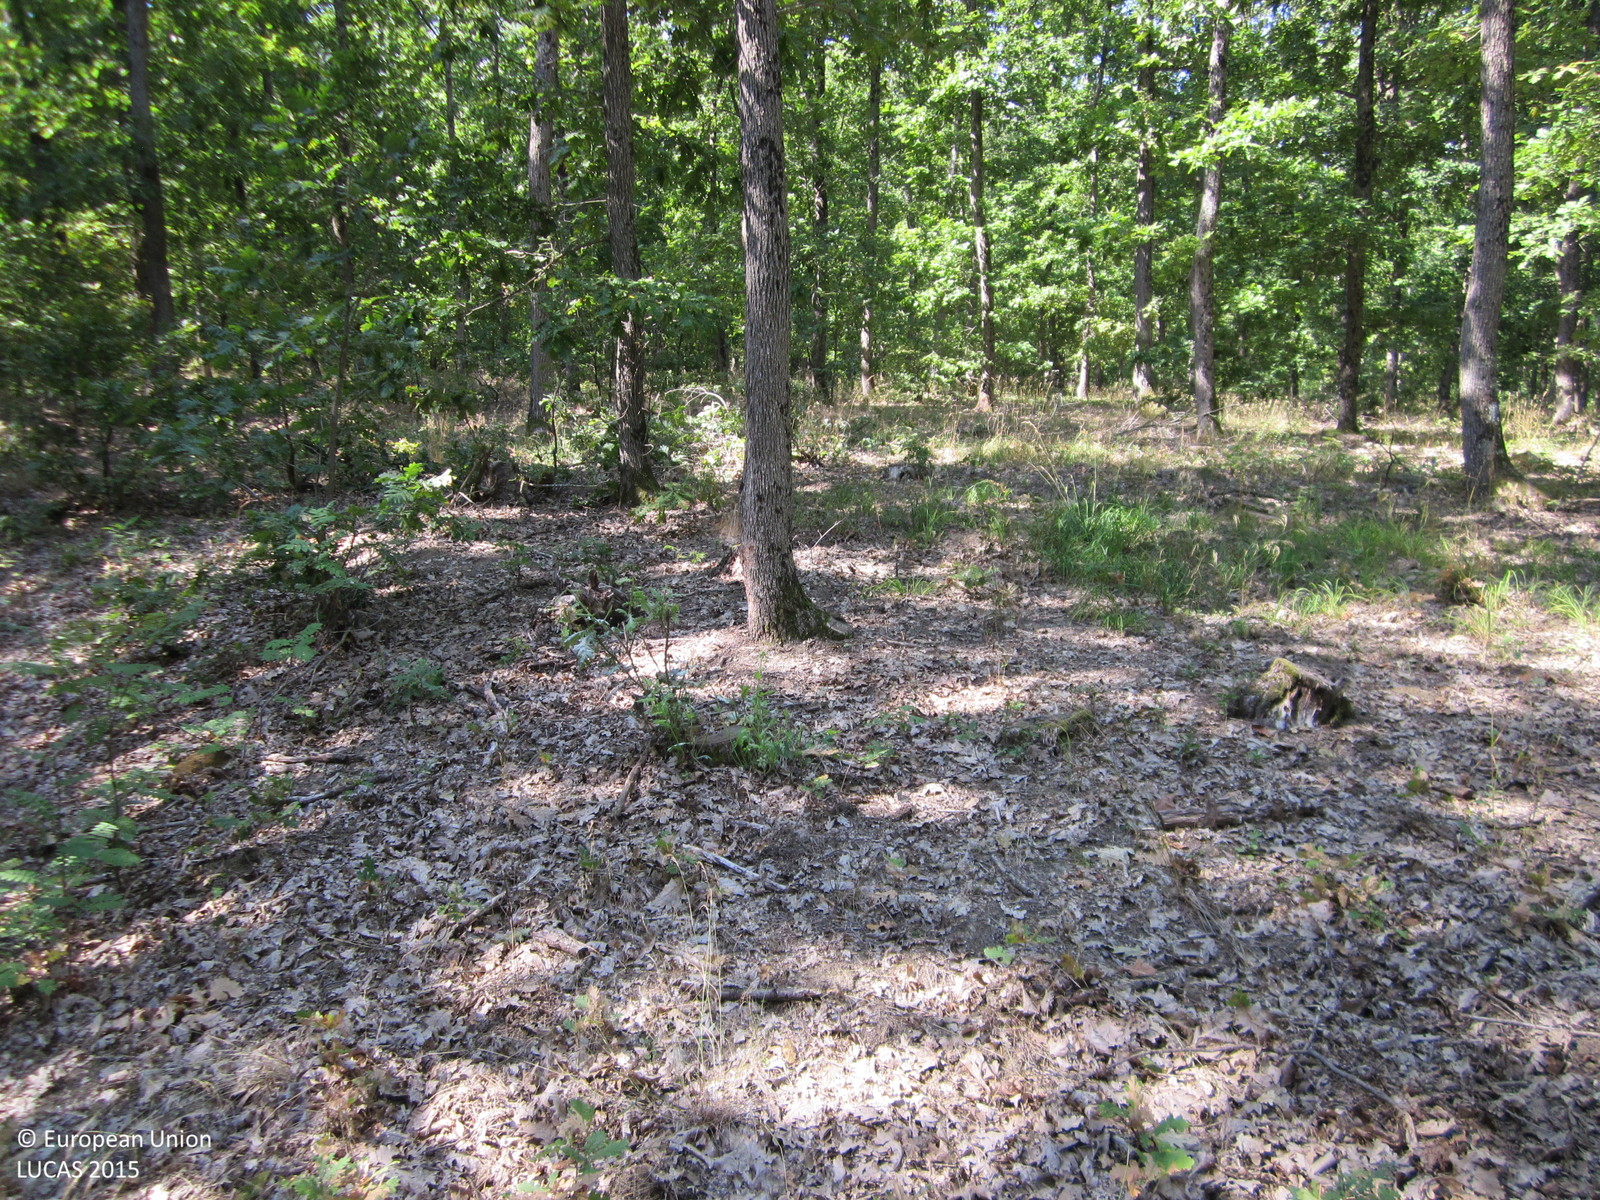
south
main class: Woodland
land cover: Broadleaved woodland
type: thermophilous deciduous forest
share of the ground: > 75 %
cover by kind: broadleaved forest trees 95 %, unconsolidated bare surface 5 %
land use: Forestry
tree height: > 5 m
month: August
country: BG
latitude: 42.8709
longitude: 27.7951
